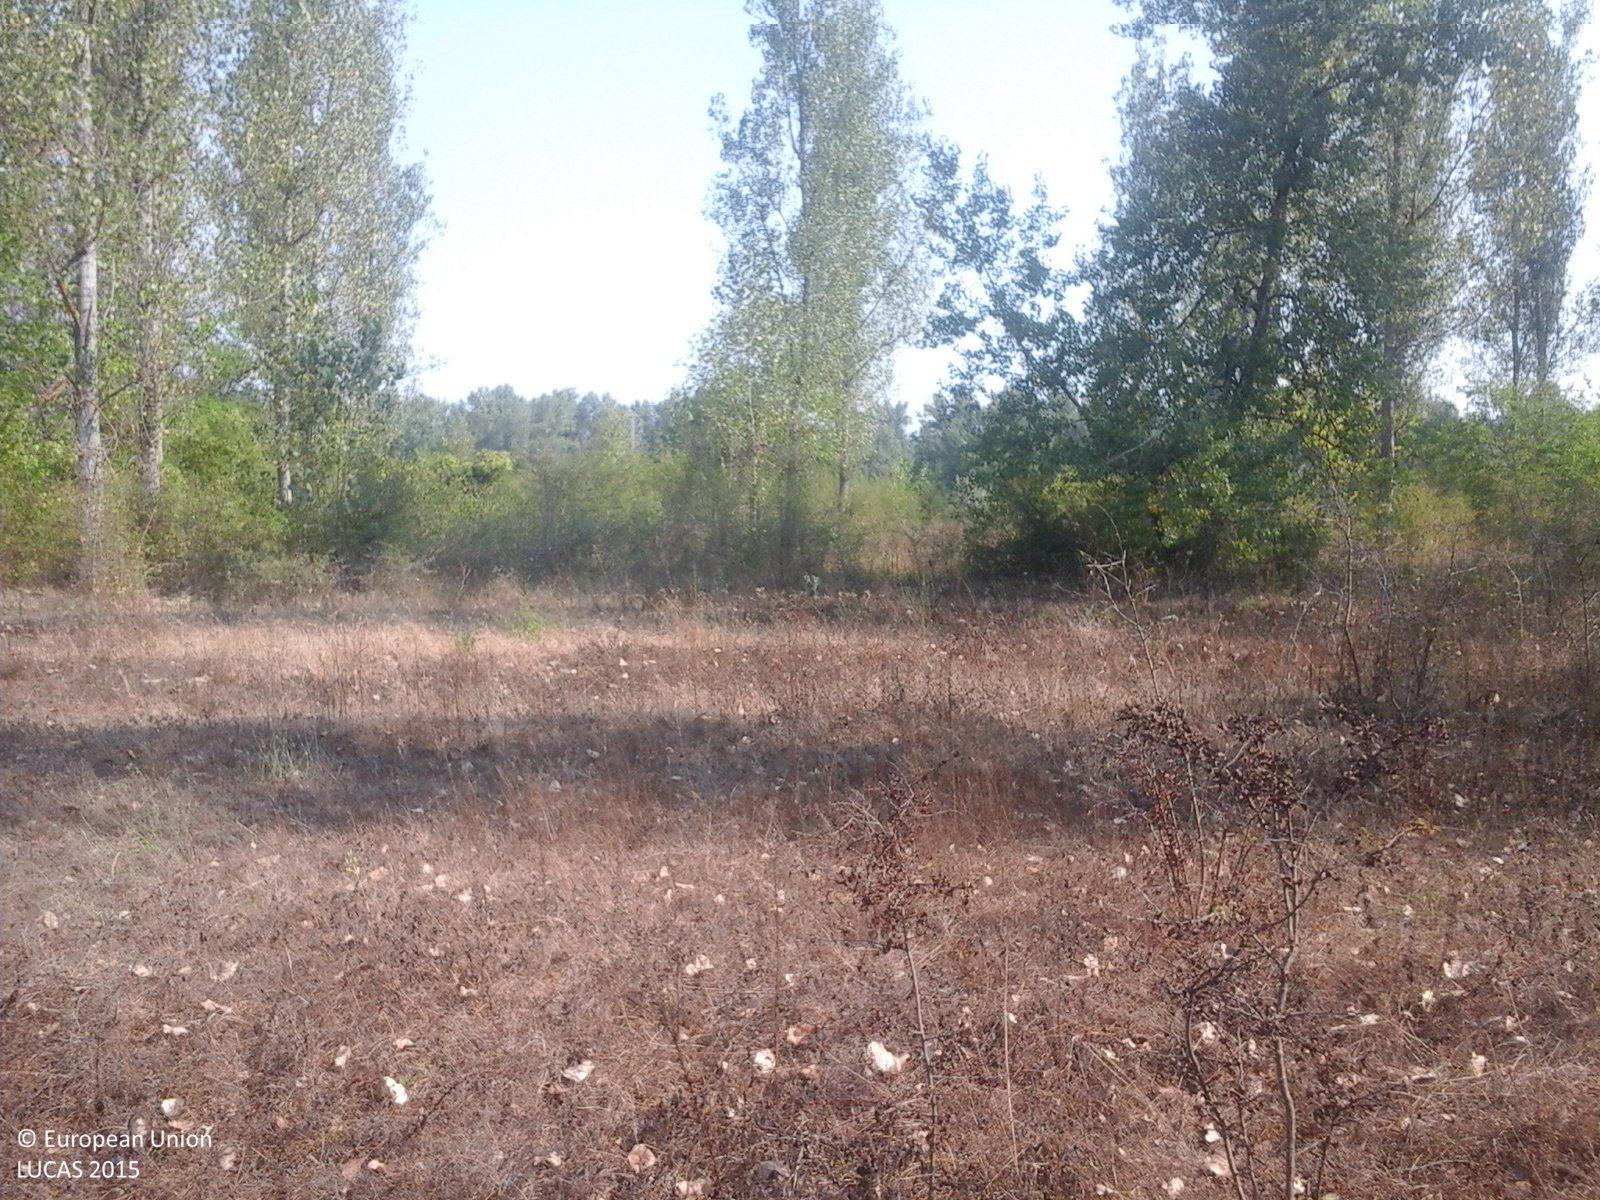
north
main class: Grassland
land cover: Grassland with sparse tree/shrub cover
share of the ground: > 75 %
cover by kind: herbaceous plants 85 %, shrubs 10 %, broadleaved forest trees 5 %
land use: Fallow land
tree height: < 5 m
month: August
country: RO
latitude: 44.7946
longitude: 23.5184
